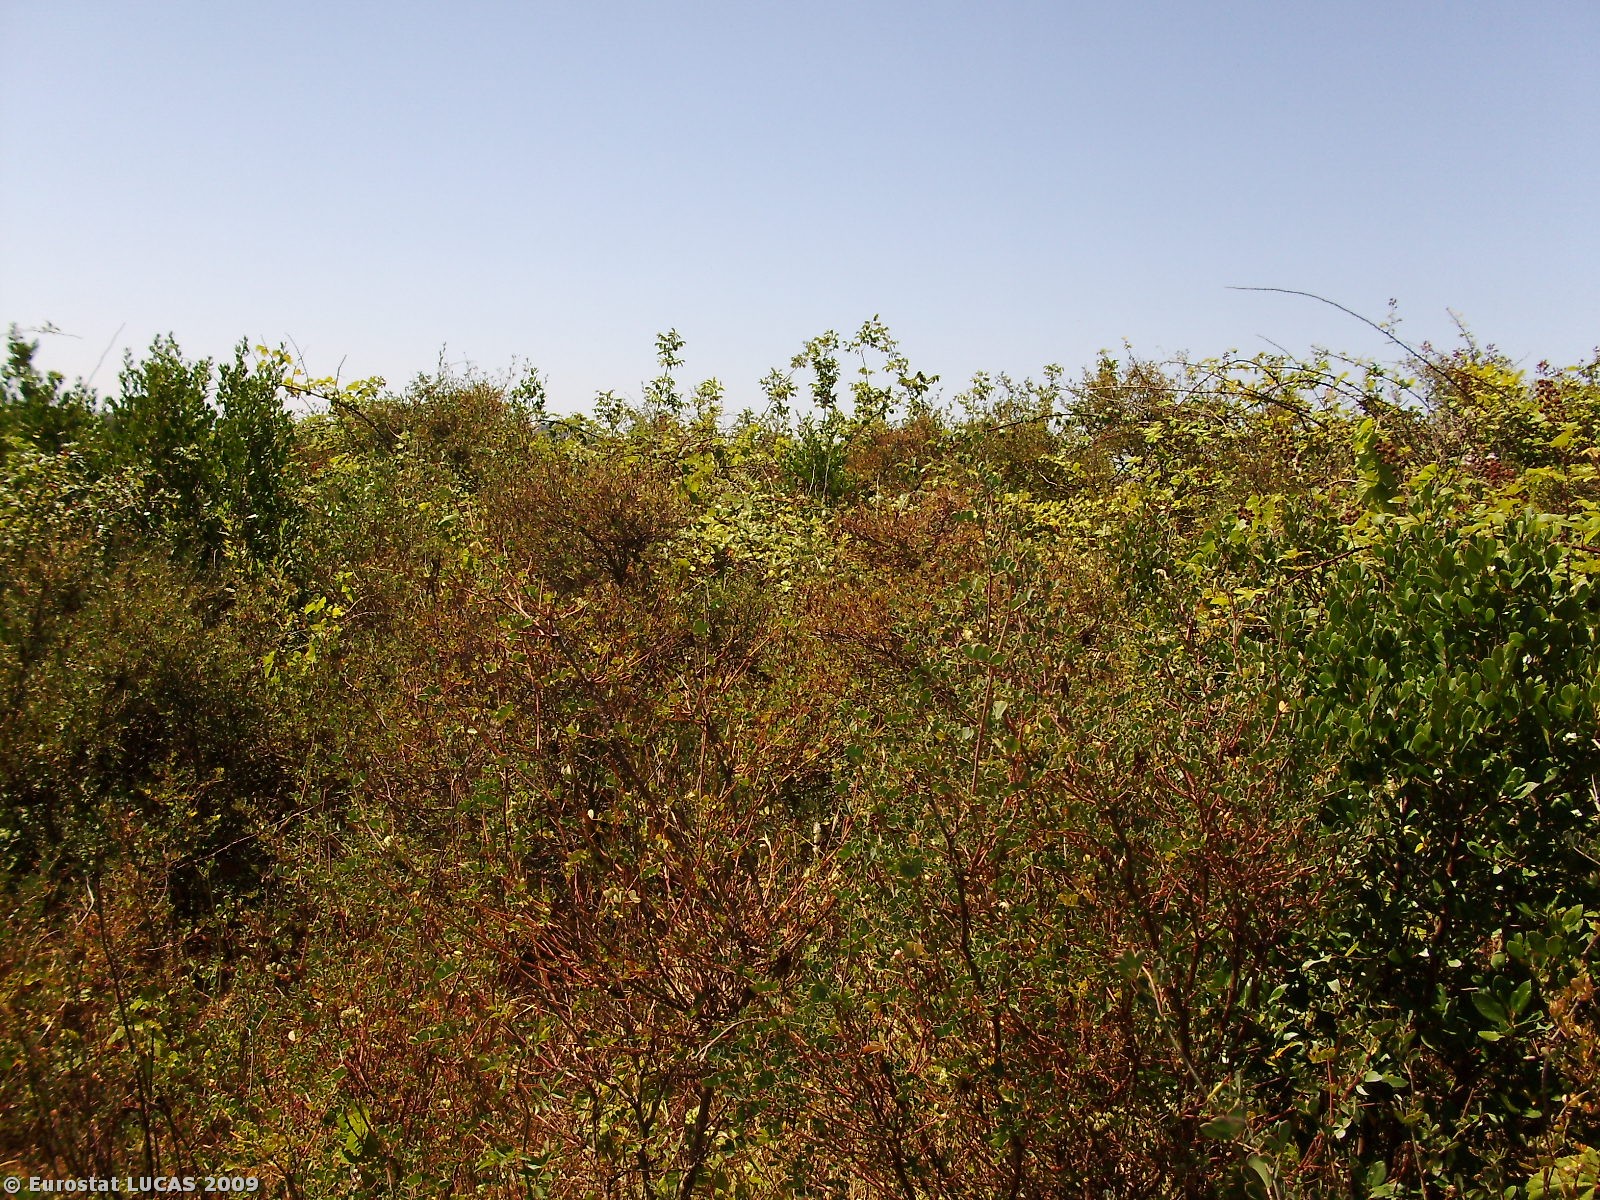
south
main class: Shrubland
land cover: Shrubland without tree cover
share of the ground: > 75 %
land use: Fallow land
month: July
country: PT
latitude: 39.6066
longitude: -8.9433
